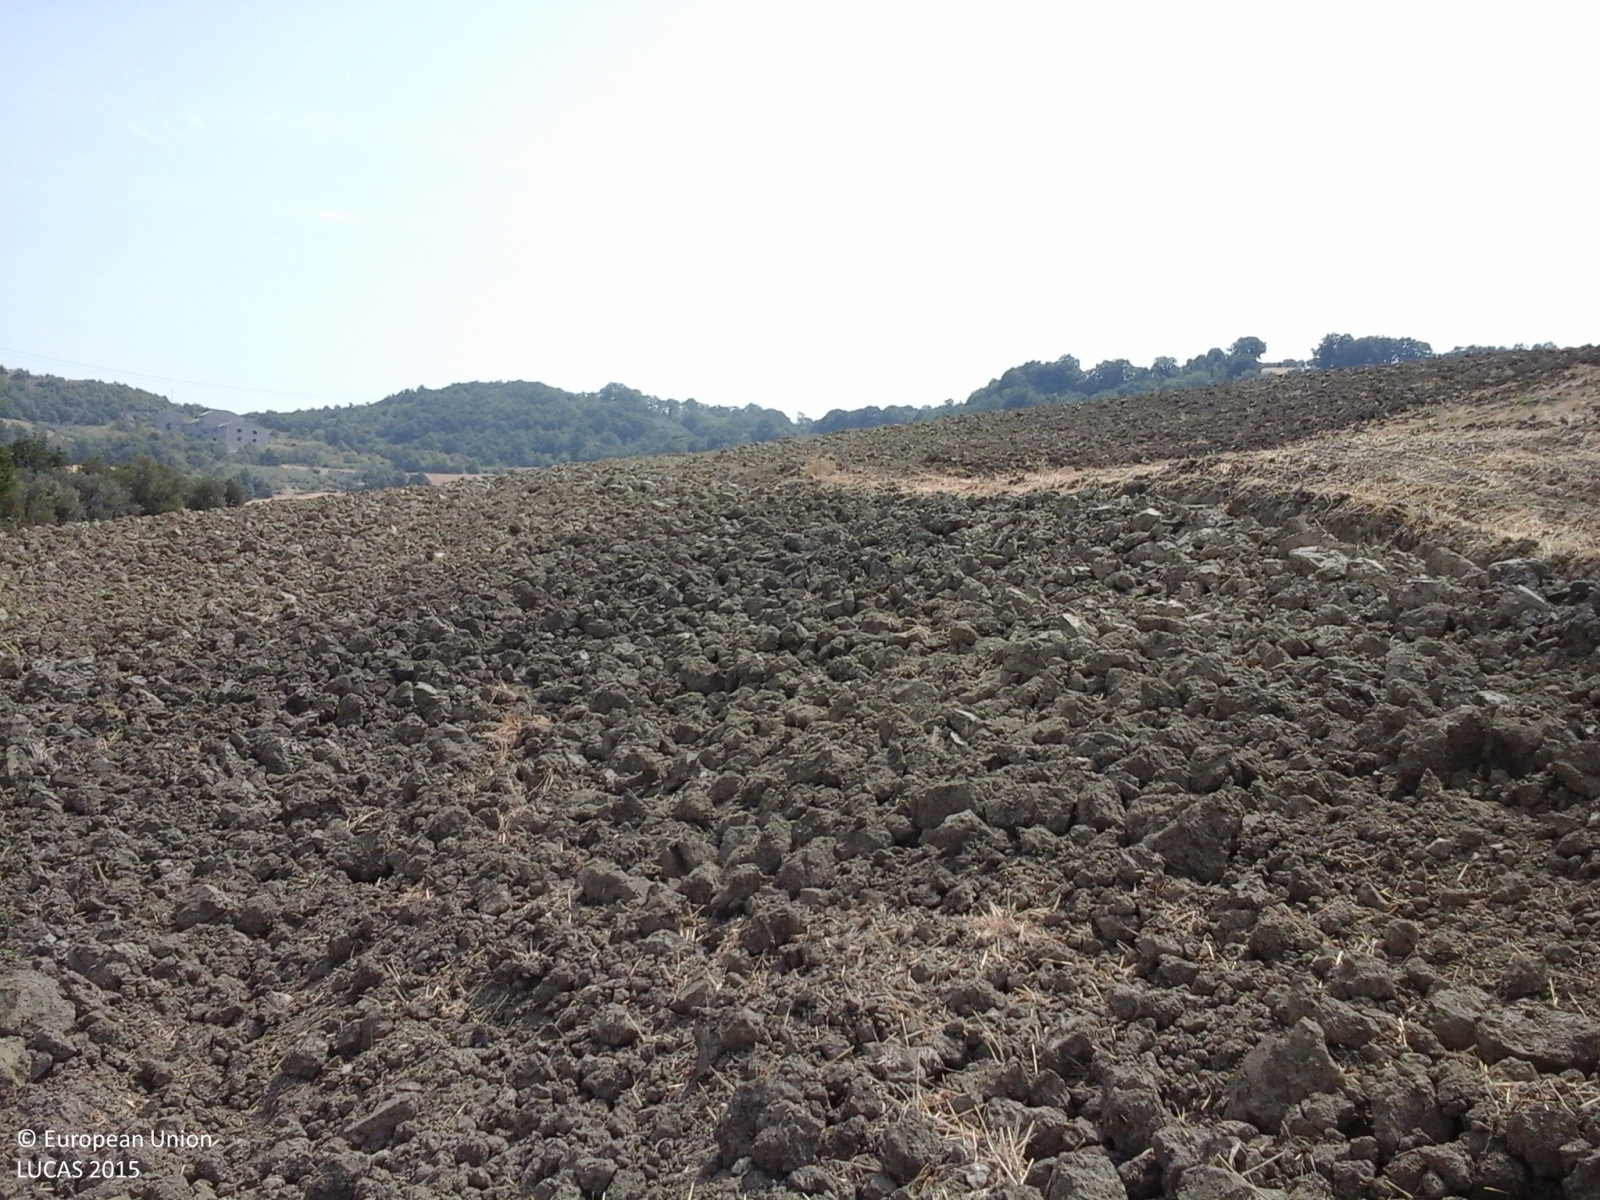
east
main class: Cropland
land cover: Durum wheat
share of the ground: > 75 %
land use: Agriculture (excluding fallow land and kitchen gardens)
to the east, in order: Durum wheat; Tracks; Dry pulses; Durum wheat
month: August
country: IT
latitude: 41.9467
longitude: 14.7257
